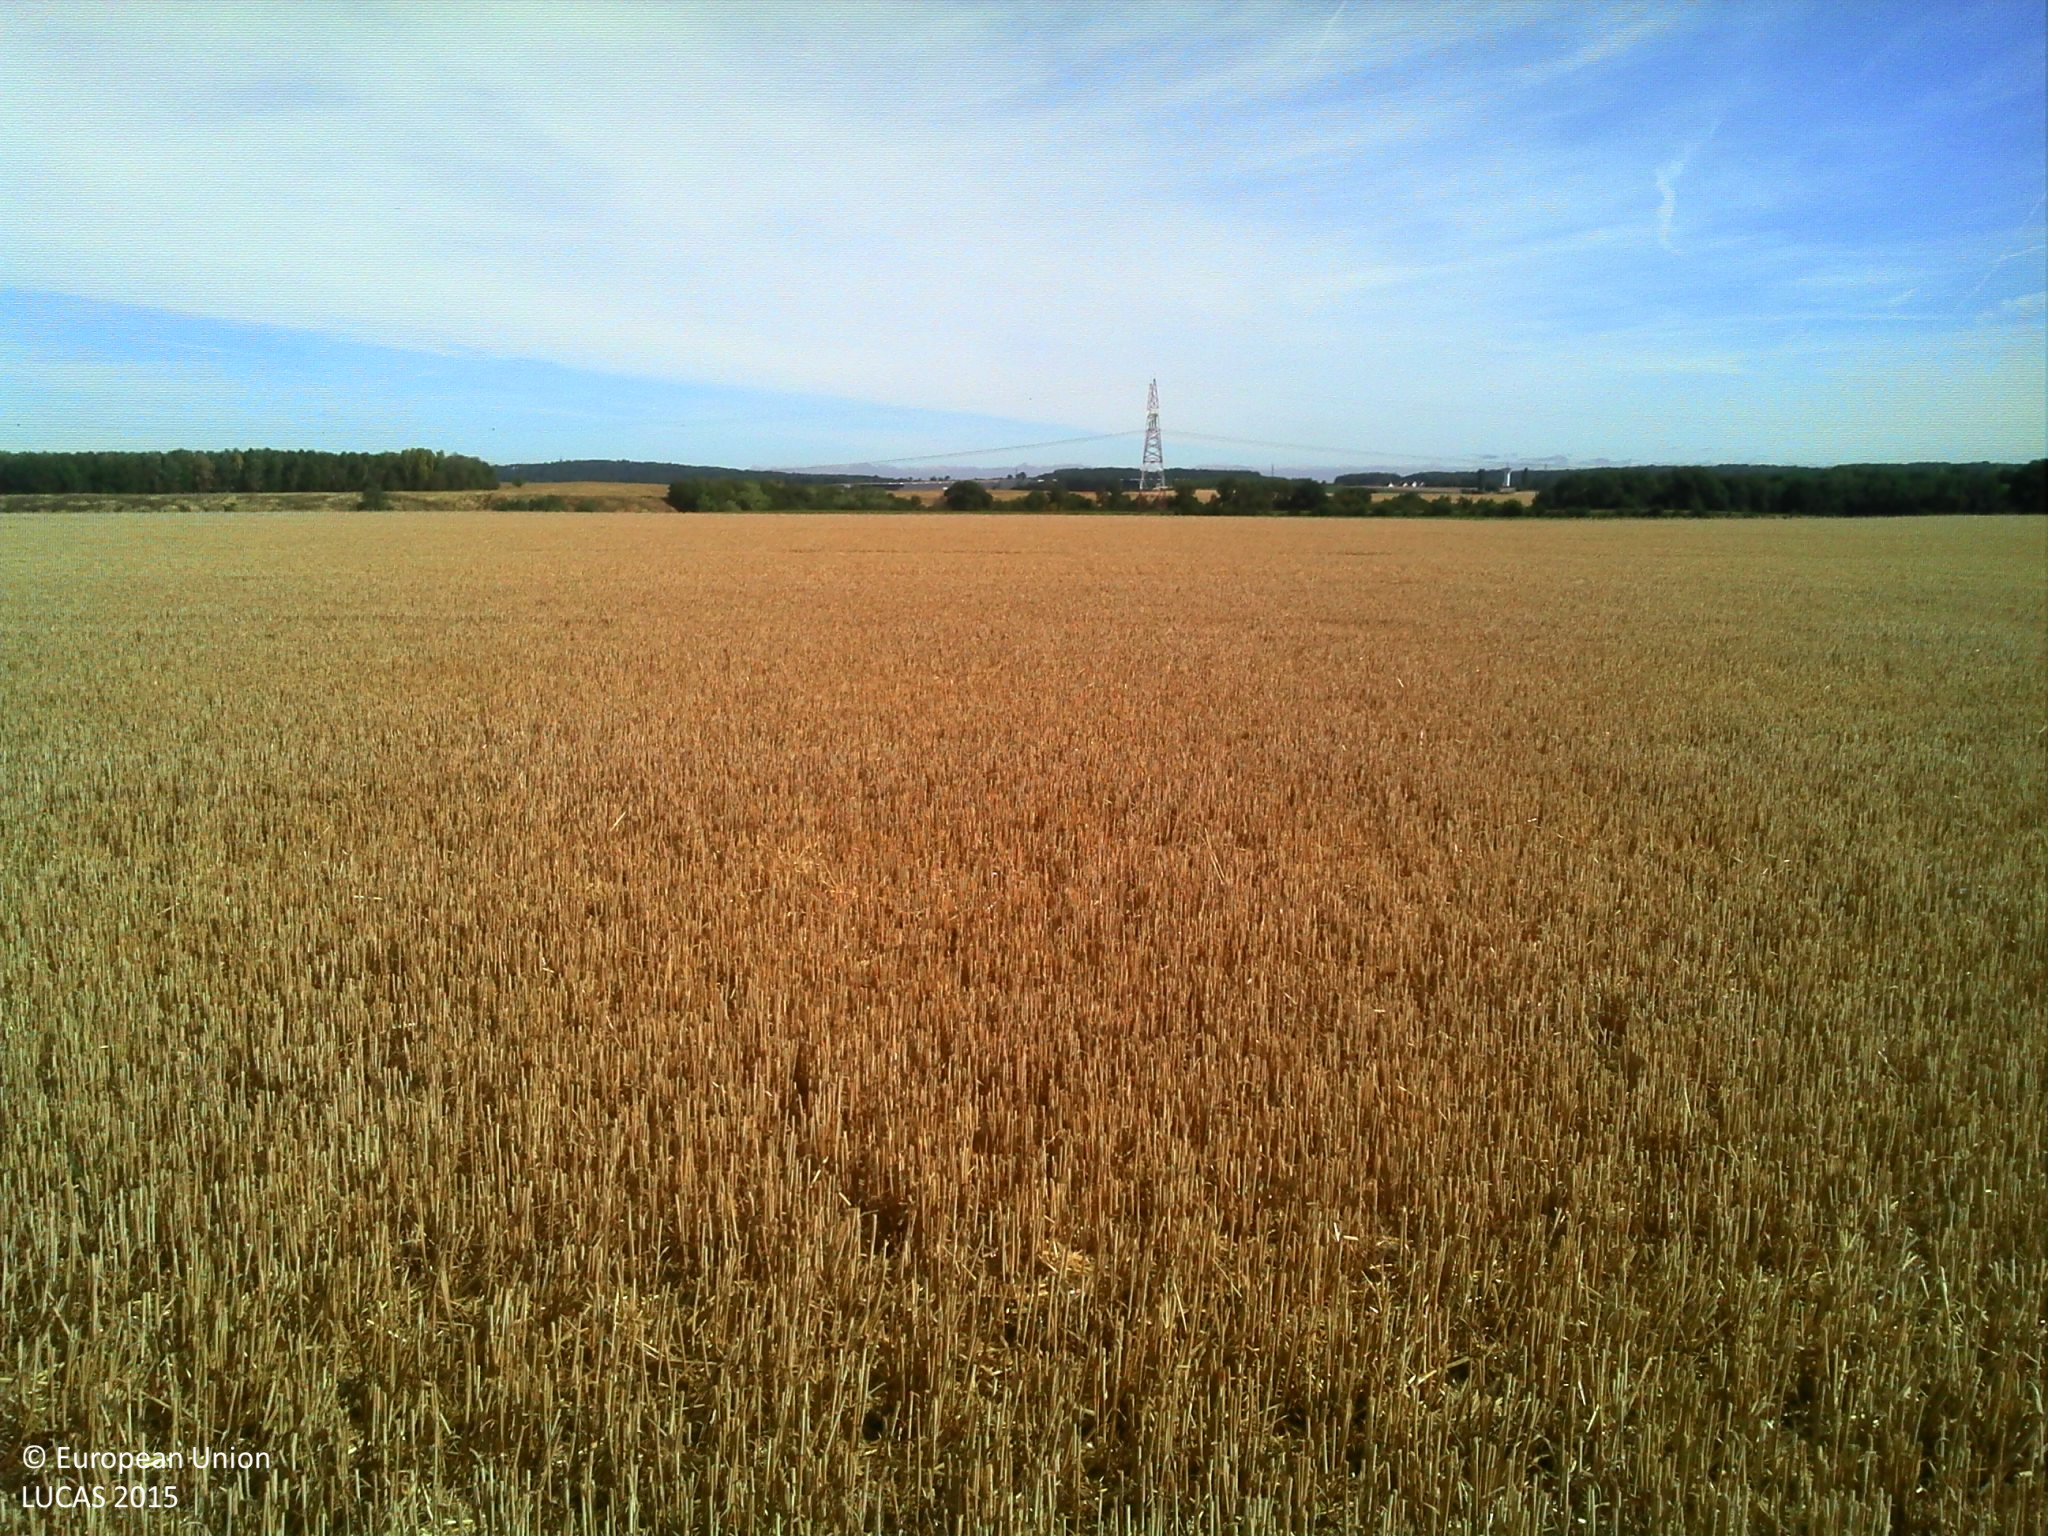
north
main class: Cropland
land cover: Common wheat
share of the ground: > 75 %
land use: Agriculture (excluding fallow land and kitchen gardens)
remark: Harvested field
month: August
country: FR
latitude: 49.0398
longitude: 2.5882
